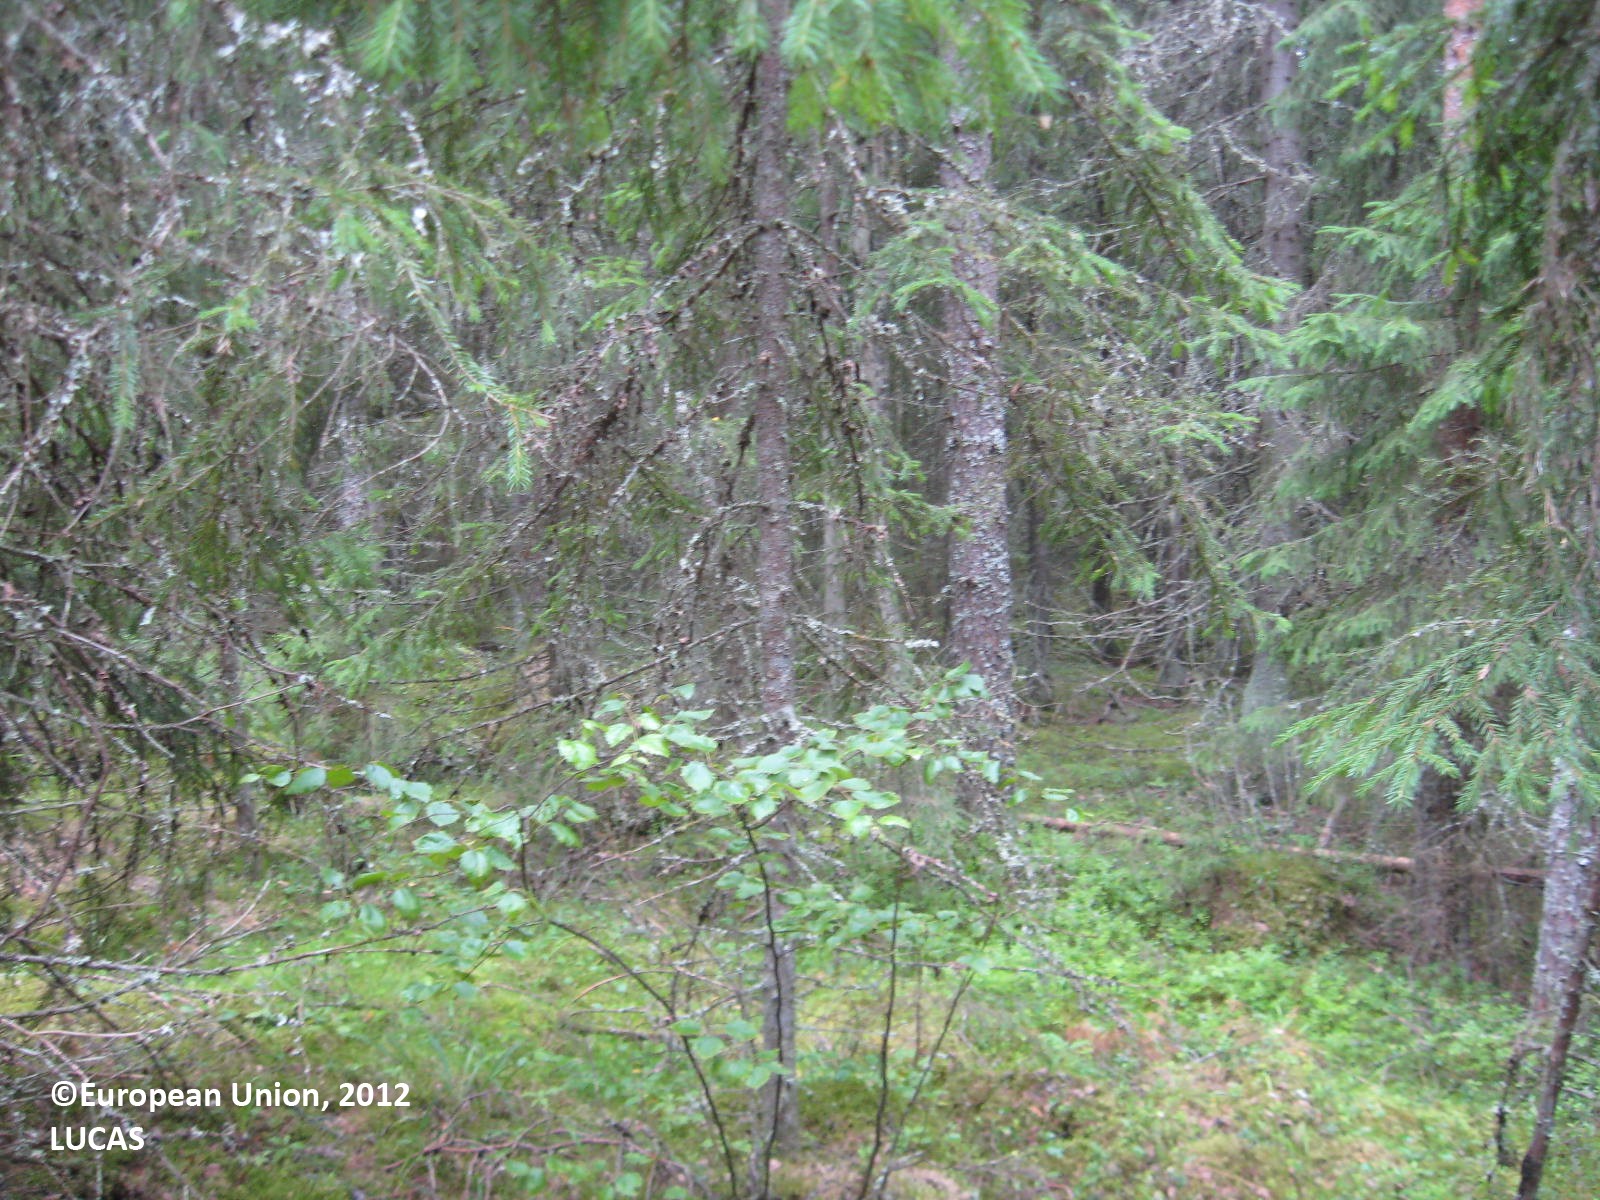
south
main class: Woodland
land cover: Other coniferous woodland
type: boreal forest
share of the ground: > 75 %
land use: Forestry
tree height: > 5 m
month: July
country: FI
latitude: 61.8741
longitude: 21.5528
